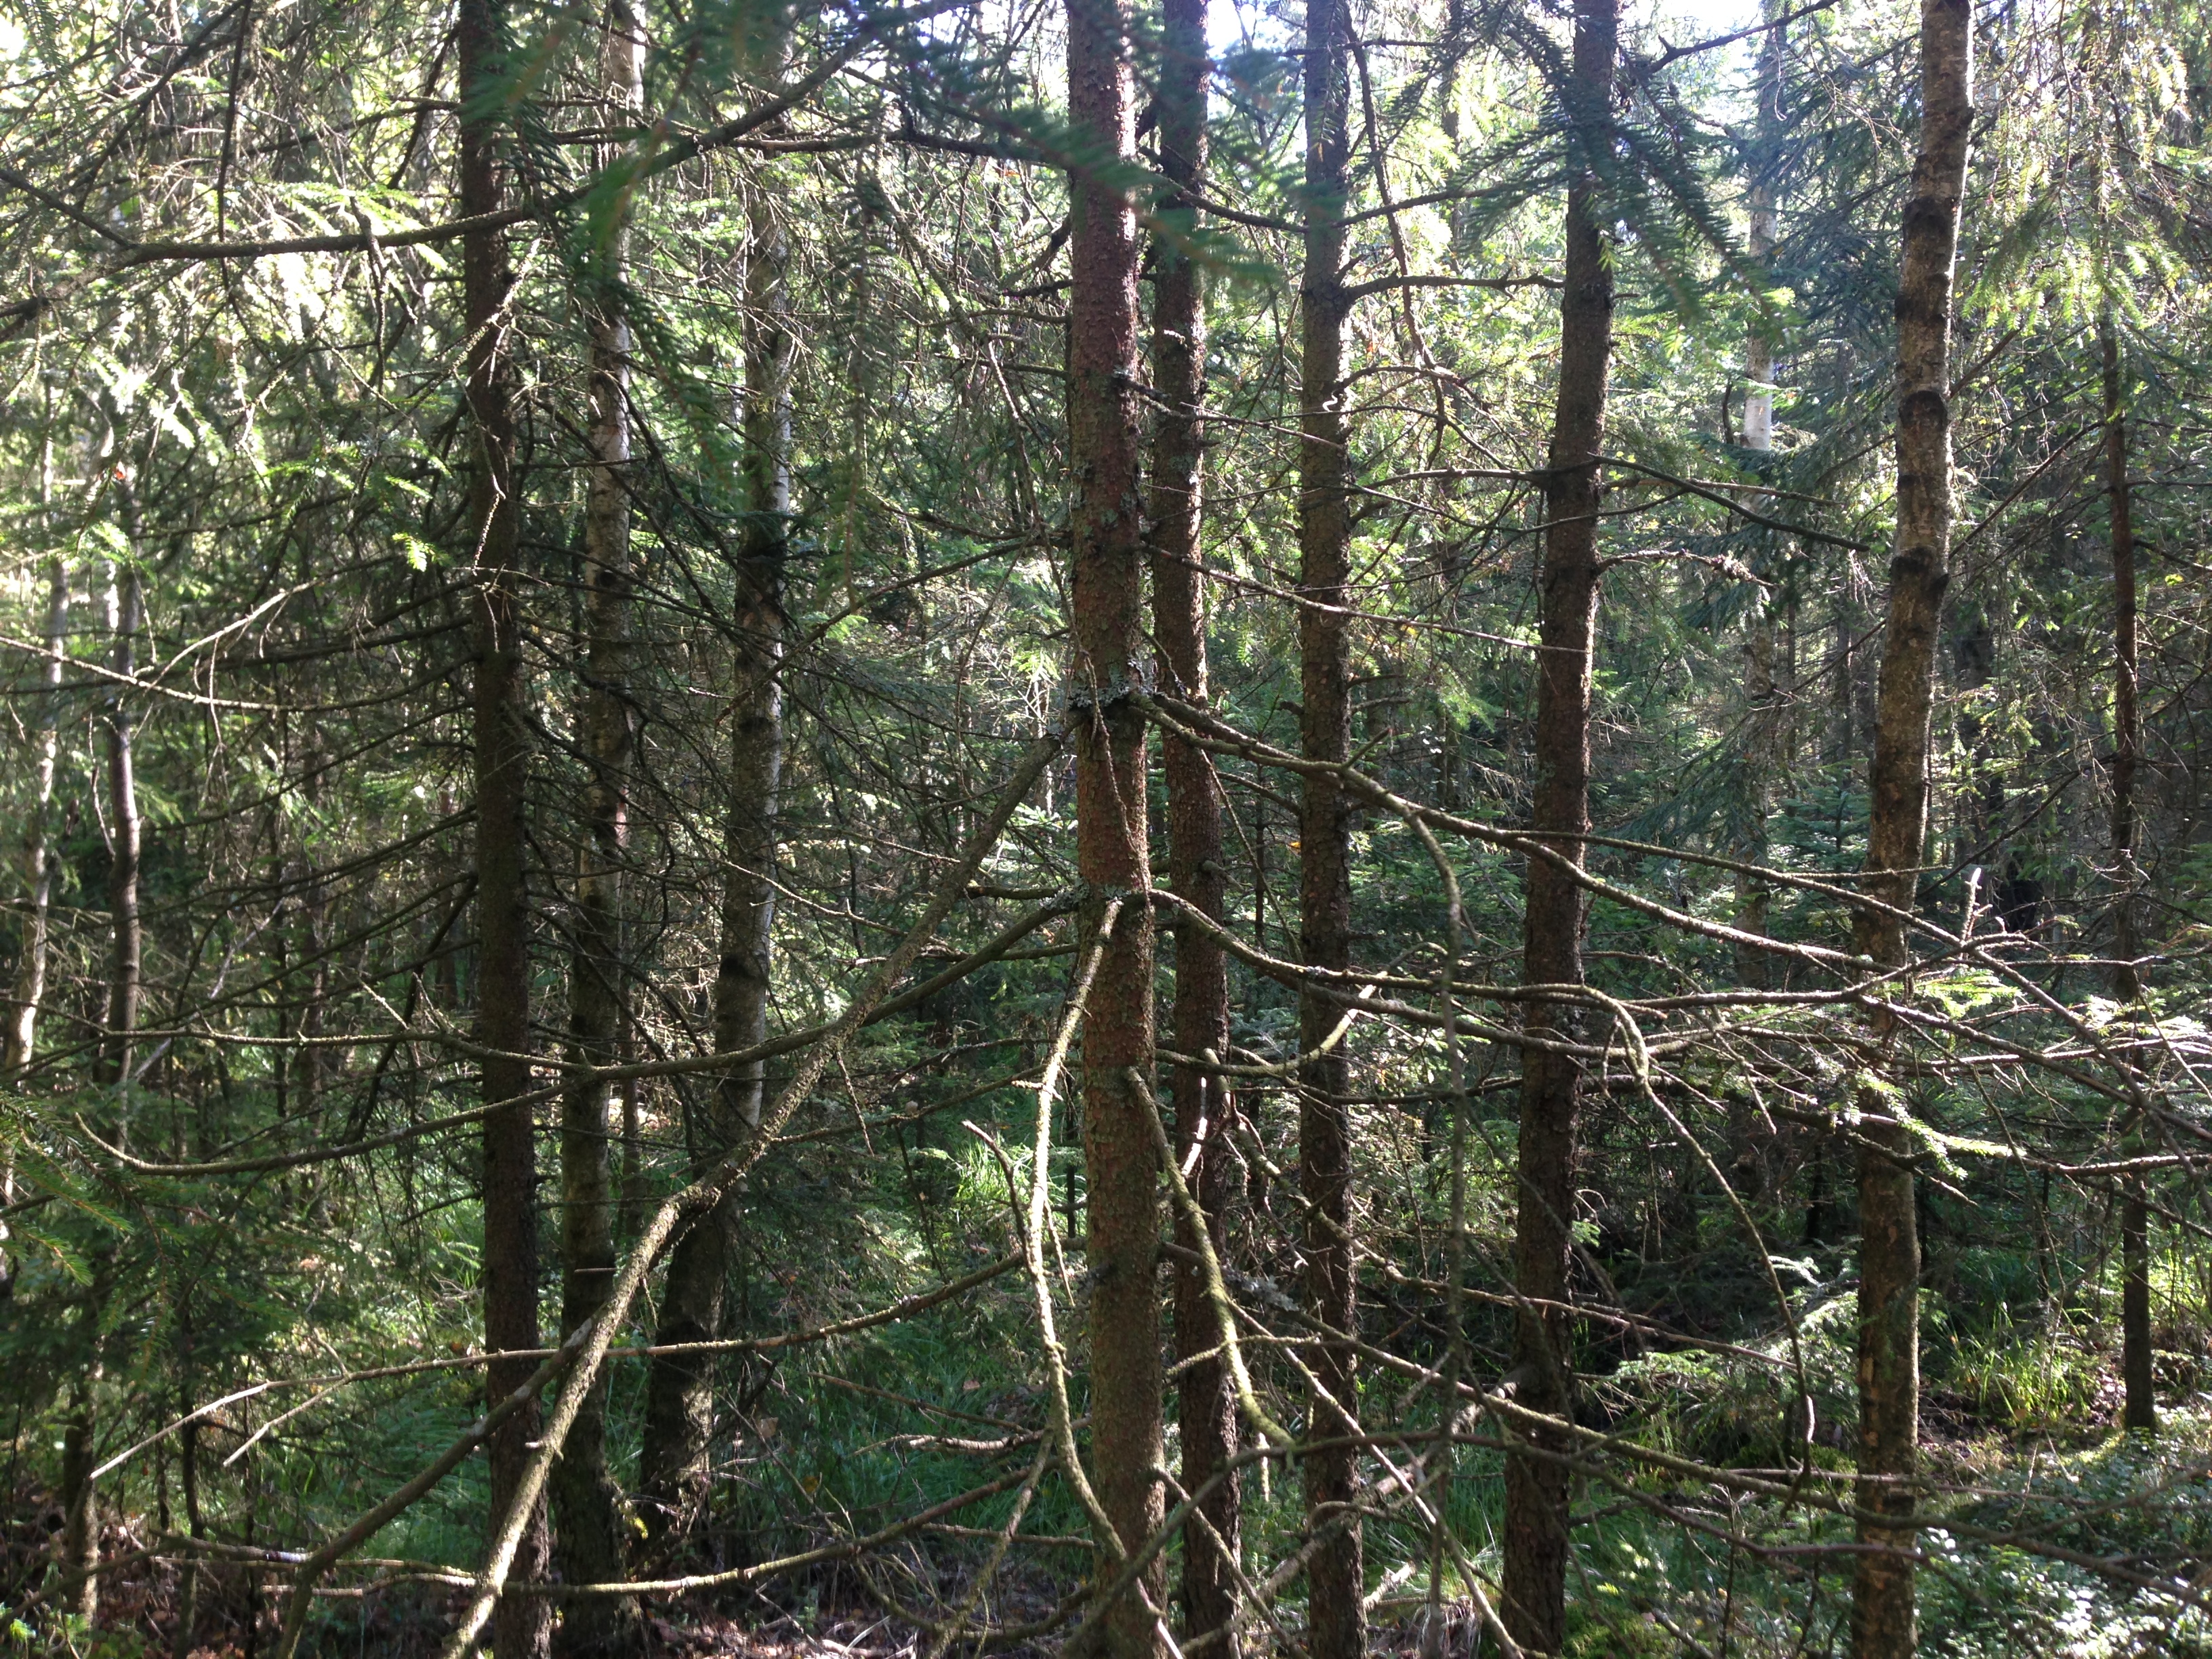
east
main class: Woodland
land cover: Pine dominated mixed woodland
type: boreal forest
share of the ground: > 75 %
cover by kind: coniferous forest trees 50 %, broadleaved forest trees 30 %, shrubs 20 %
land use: Forestry
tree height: > 5 m
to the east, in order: Pine dominated mixed woodland; Pine dominated coniferous woodland; Spruce dominated mixed woodland; Ditches and canals; Spruce dominated mixed woodland; Electric lines; Pine dominated coniferous woodland; Pine dominated mixed woodland
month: September
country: SE
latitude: 57.1183
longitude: 13.2497
